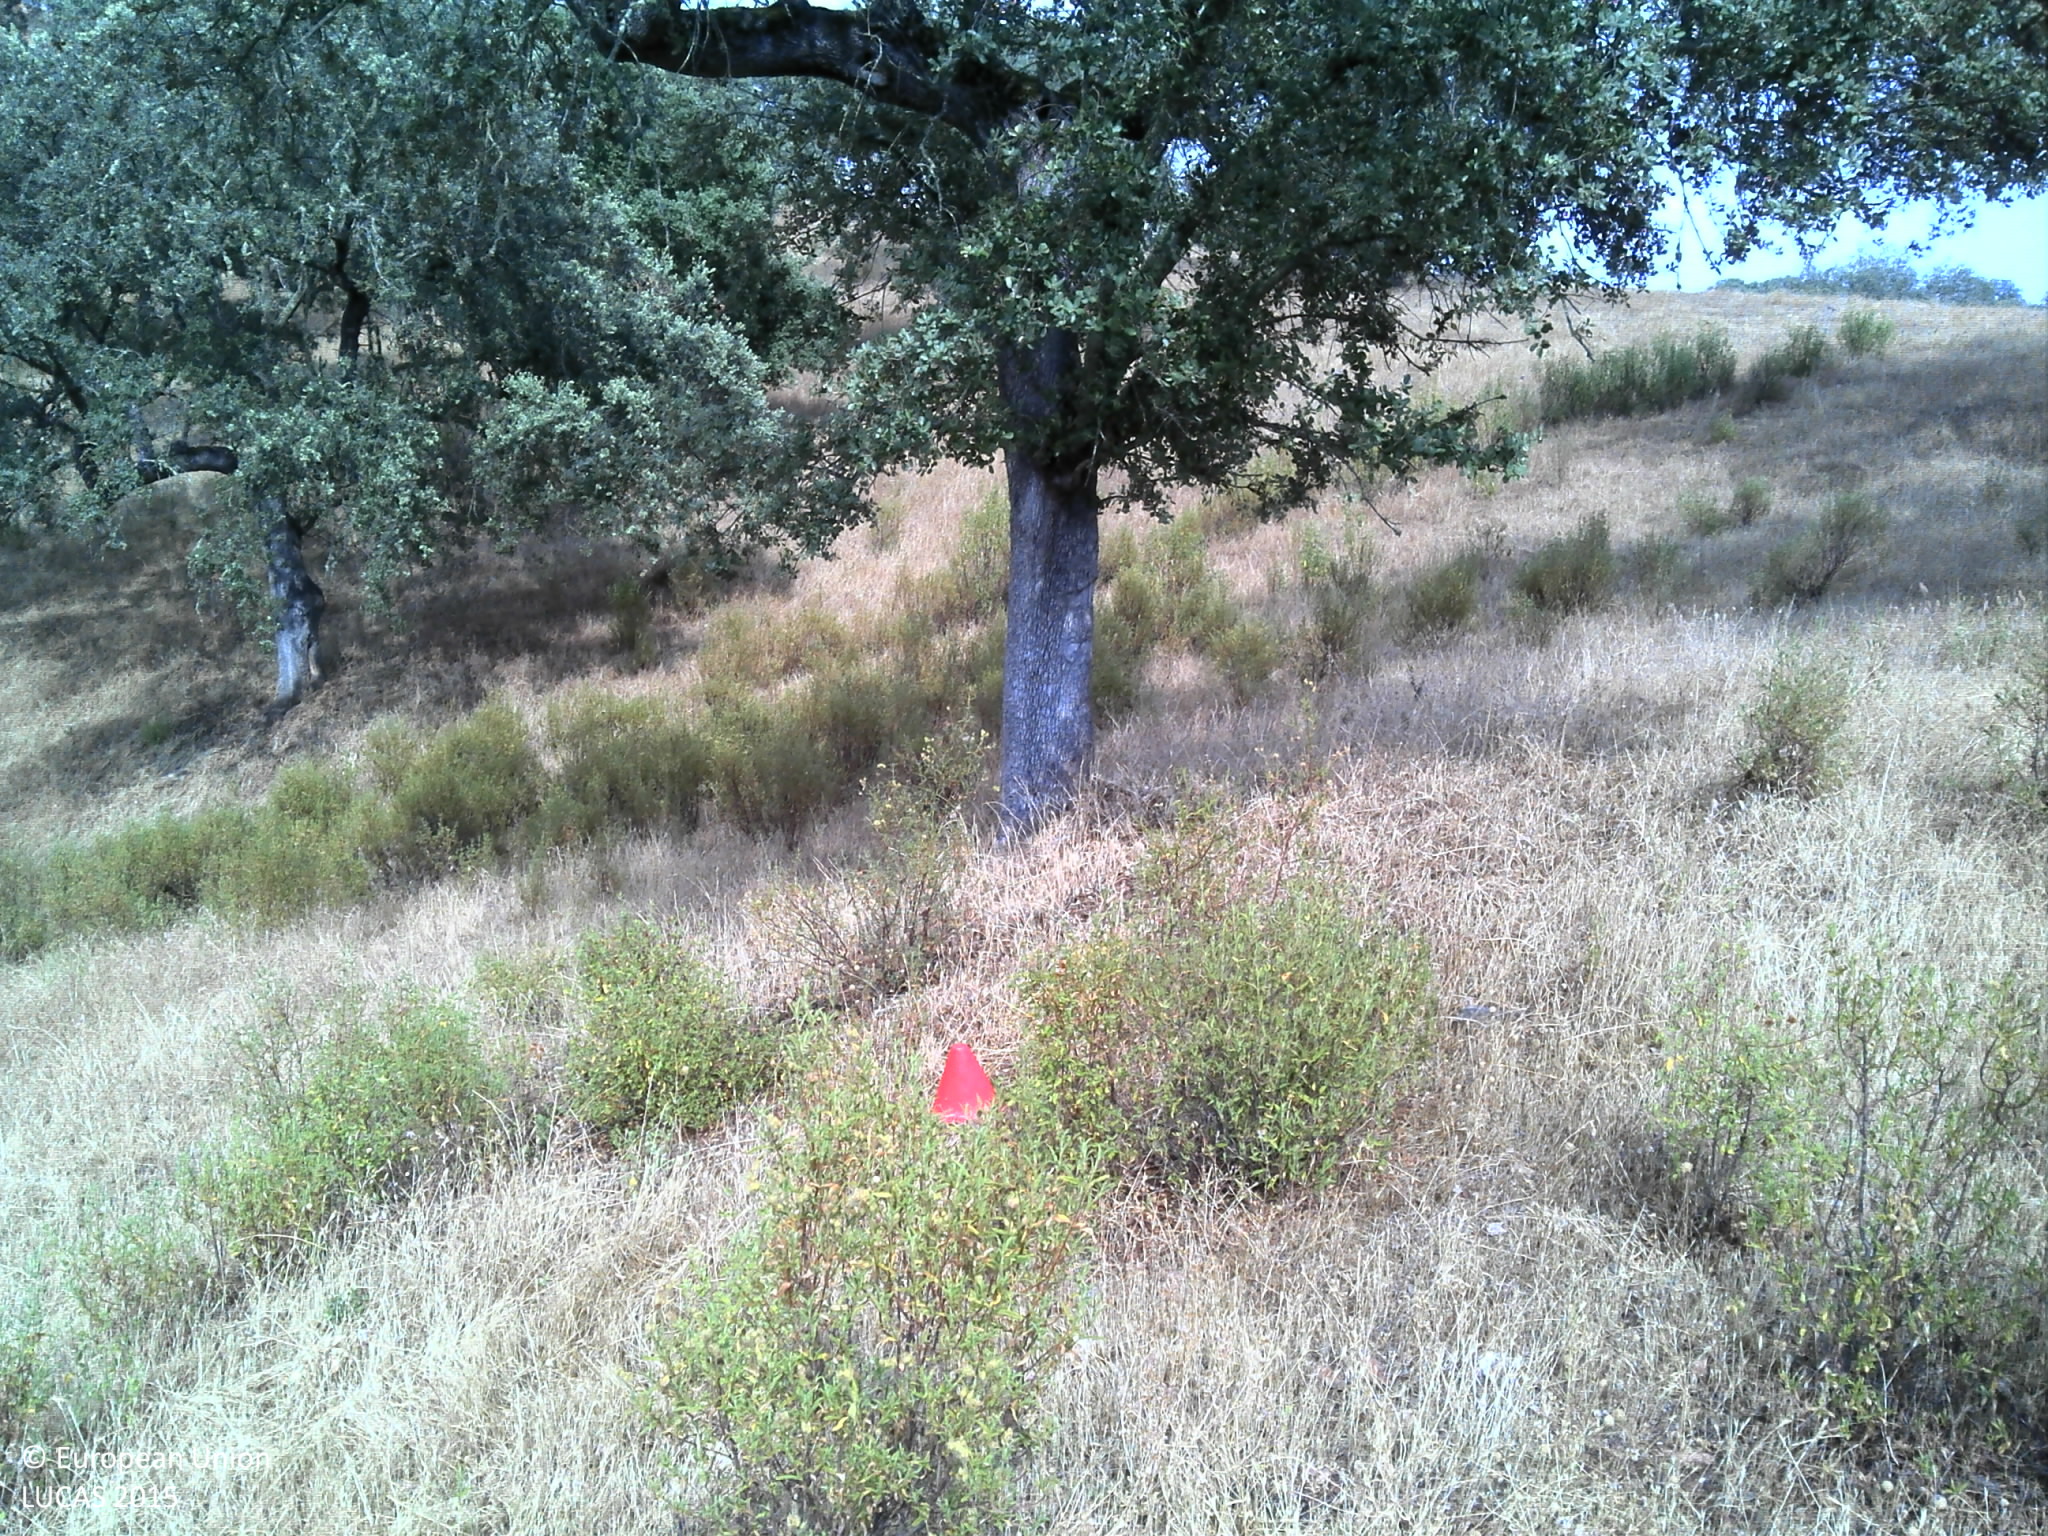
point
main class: Woodland
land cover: Broadleaved woodland
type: broadleaved evergreen forest
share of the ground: 25 - 50 %
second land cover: Grassland without tree/shrub cover
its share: 50 - 75 %
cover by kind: herbaceous plants 55 %, broadleaved forest trees 40 %, unconsolidated bare surface 5 %
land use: Forestry
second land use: Agriculture (excluding fallow land and kitchen gardens)
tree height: > 5 m
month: June
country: PT
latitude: 37.8409
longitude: -7.6439
